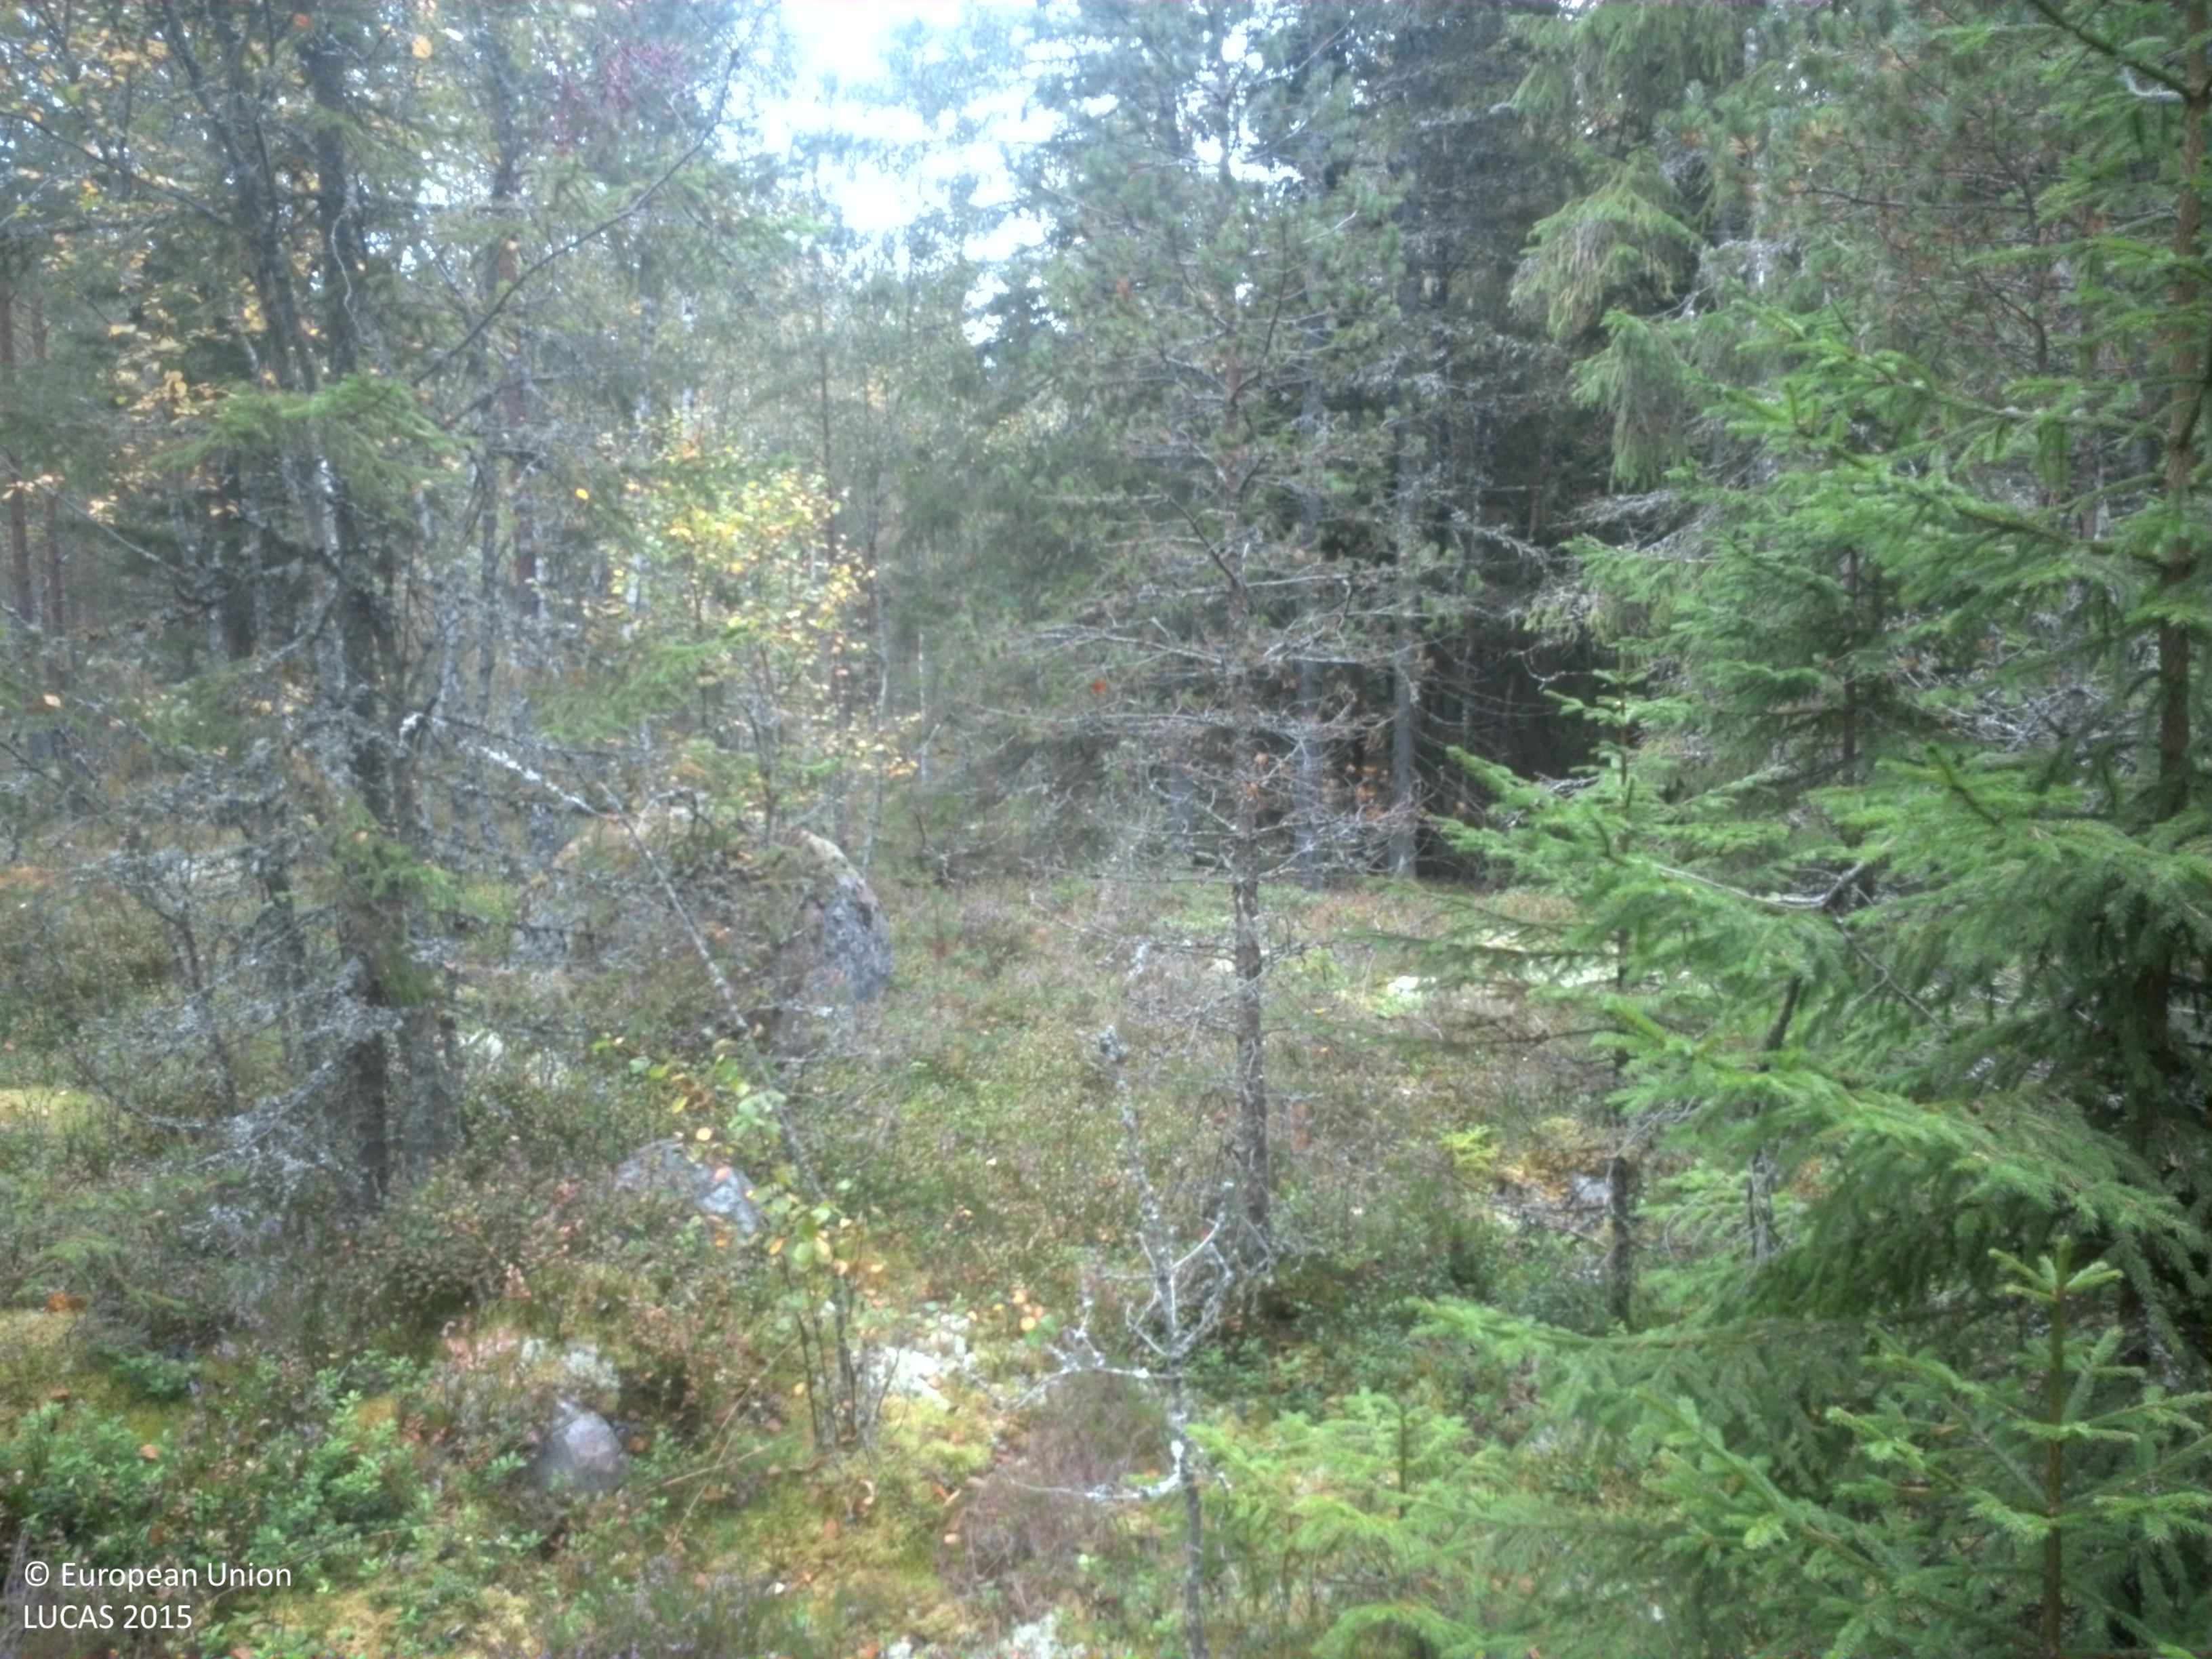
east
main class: Woodland
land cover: Pine dominated mixed woodland
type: boreal forest
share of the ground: > 75 %
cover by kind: coniferous forest trees 55 %, broadleaved forest trees 20 %, shrubs 15 %, lichens and mosses 5 %, consolidated bare surface 5 %
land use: Forestry
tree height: > 5 m
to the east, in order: Pine dominated mixed woodland; Spruce dominated coniferous woodland; Pine dominated coniferous woodland; Tracks; Pine dominated mixed woodland; Pine dominated coniferous woodland
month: September
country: SE
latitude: 59.4042
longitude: 15.5400
